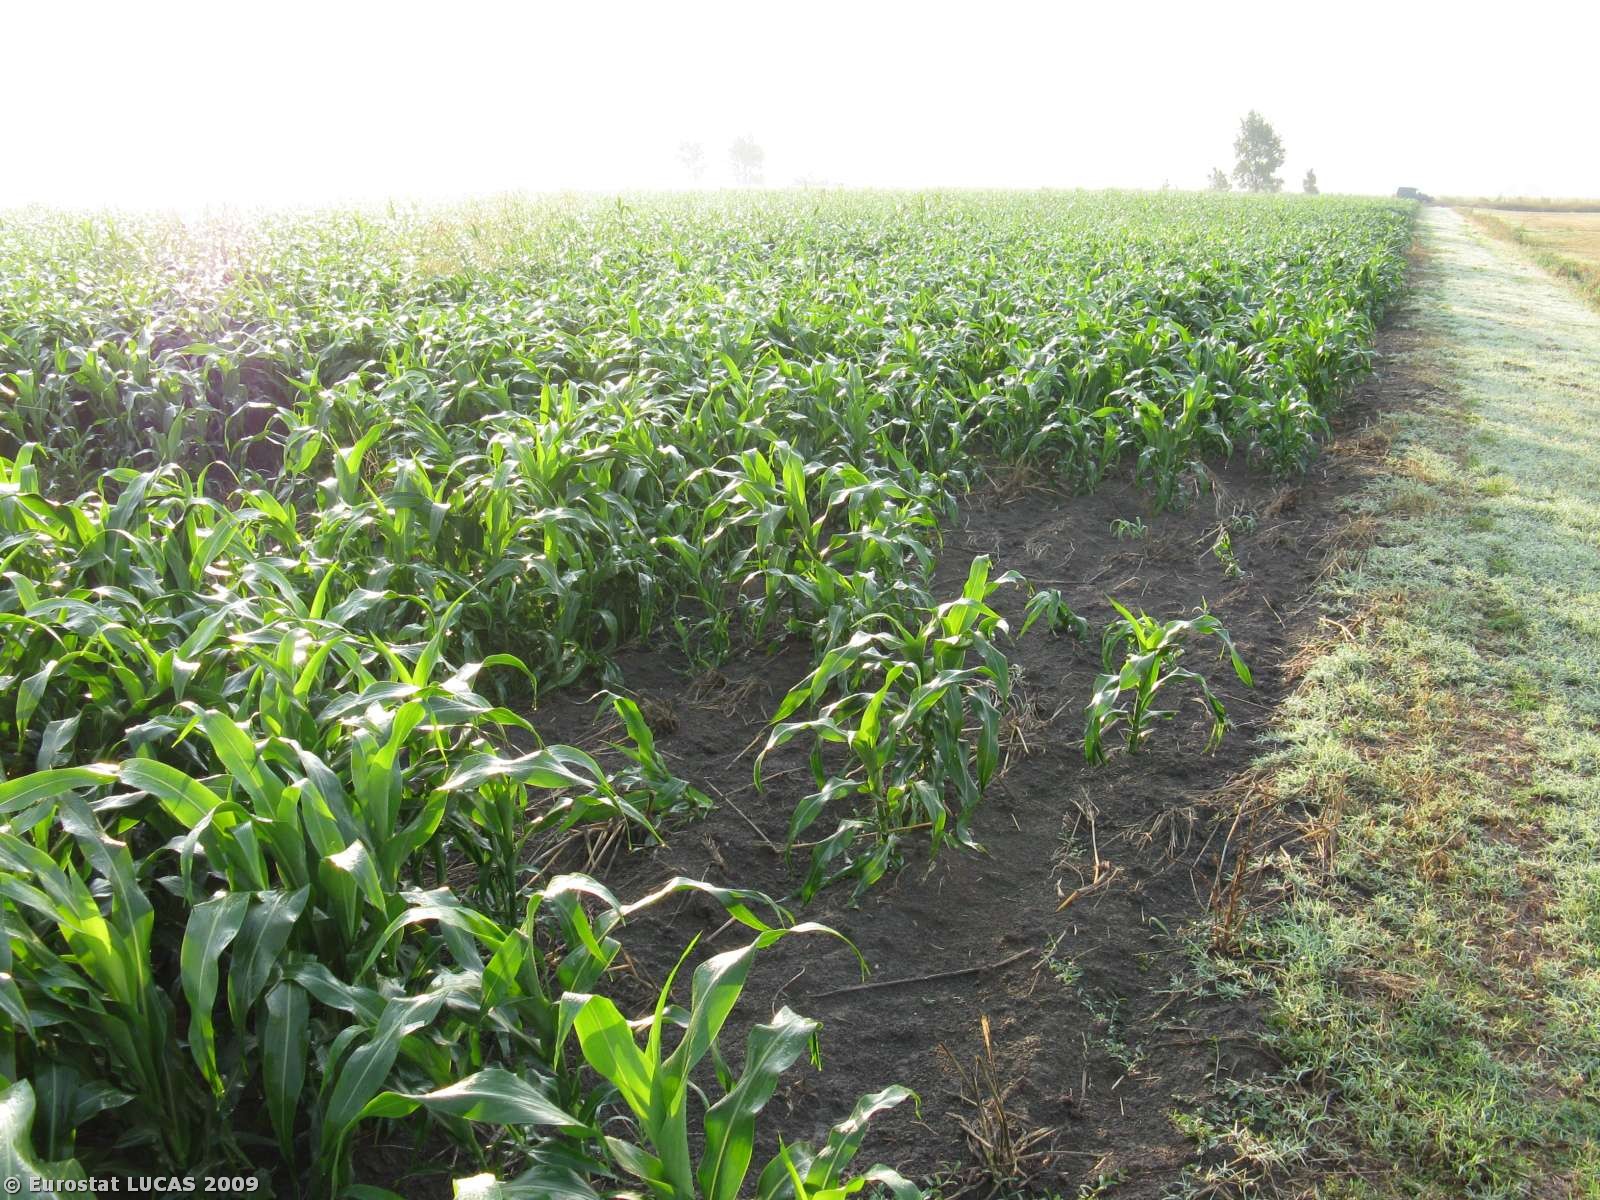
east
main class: Cropland
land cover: Other cereals
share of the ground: > 75 %
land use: Agriculture (excluding fallow land and kitchen gardens)
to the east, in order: Other cereals; Ditches and canals; Other cereals; Ditches and canals; Other cereals; Ditches and canals; Grassland with sparse tree/shrub cover
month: July
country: IT
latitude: 44.7695
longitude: 11.7024
